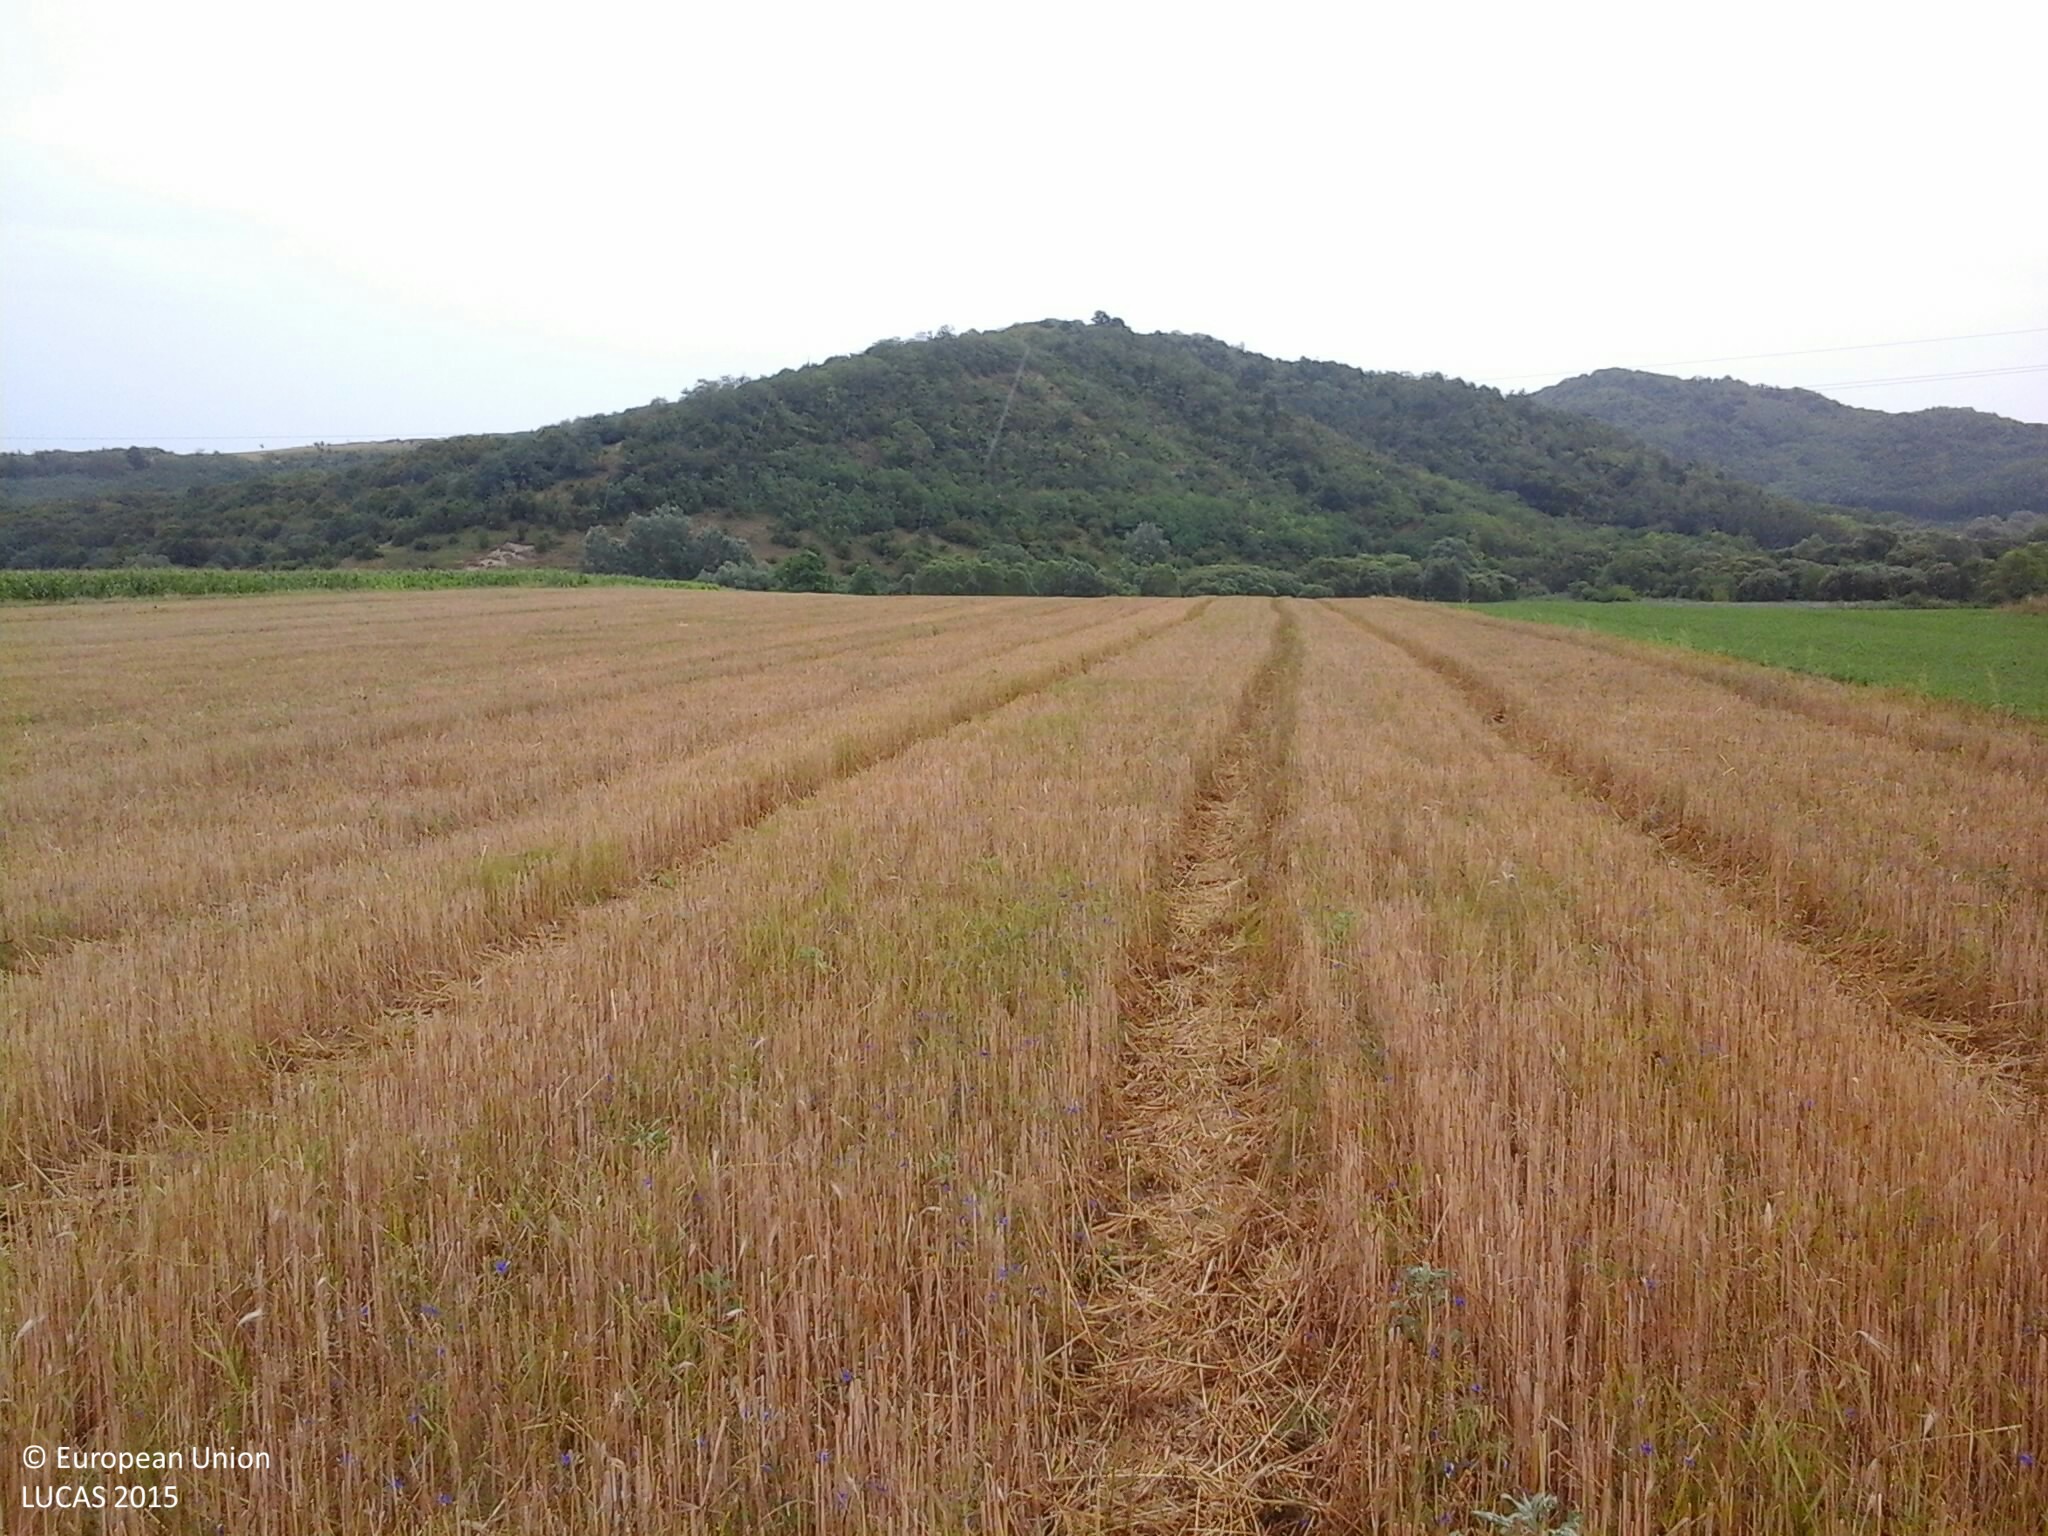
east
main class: Cropland
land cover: Barley
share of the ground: 25 - 50 %
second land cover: Spontaneously vegetated surfaces
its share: < 10 %
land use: Agriculture (excluding fallow land and kitchen gardens)
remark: Harvested field
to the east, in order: Barley; Spontaneously vegetated surfaces; Electric lines; Barley; Grass margins; Maize
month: July
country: HU
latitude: 47.9696
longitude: 19.3581
